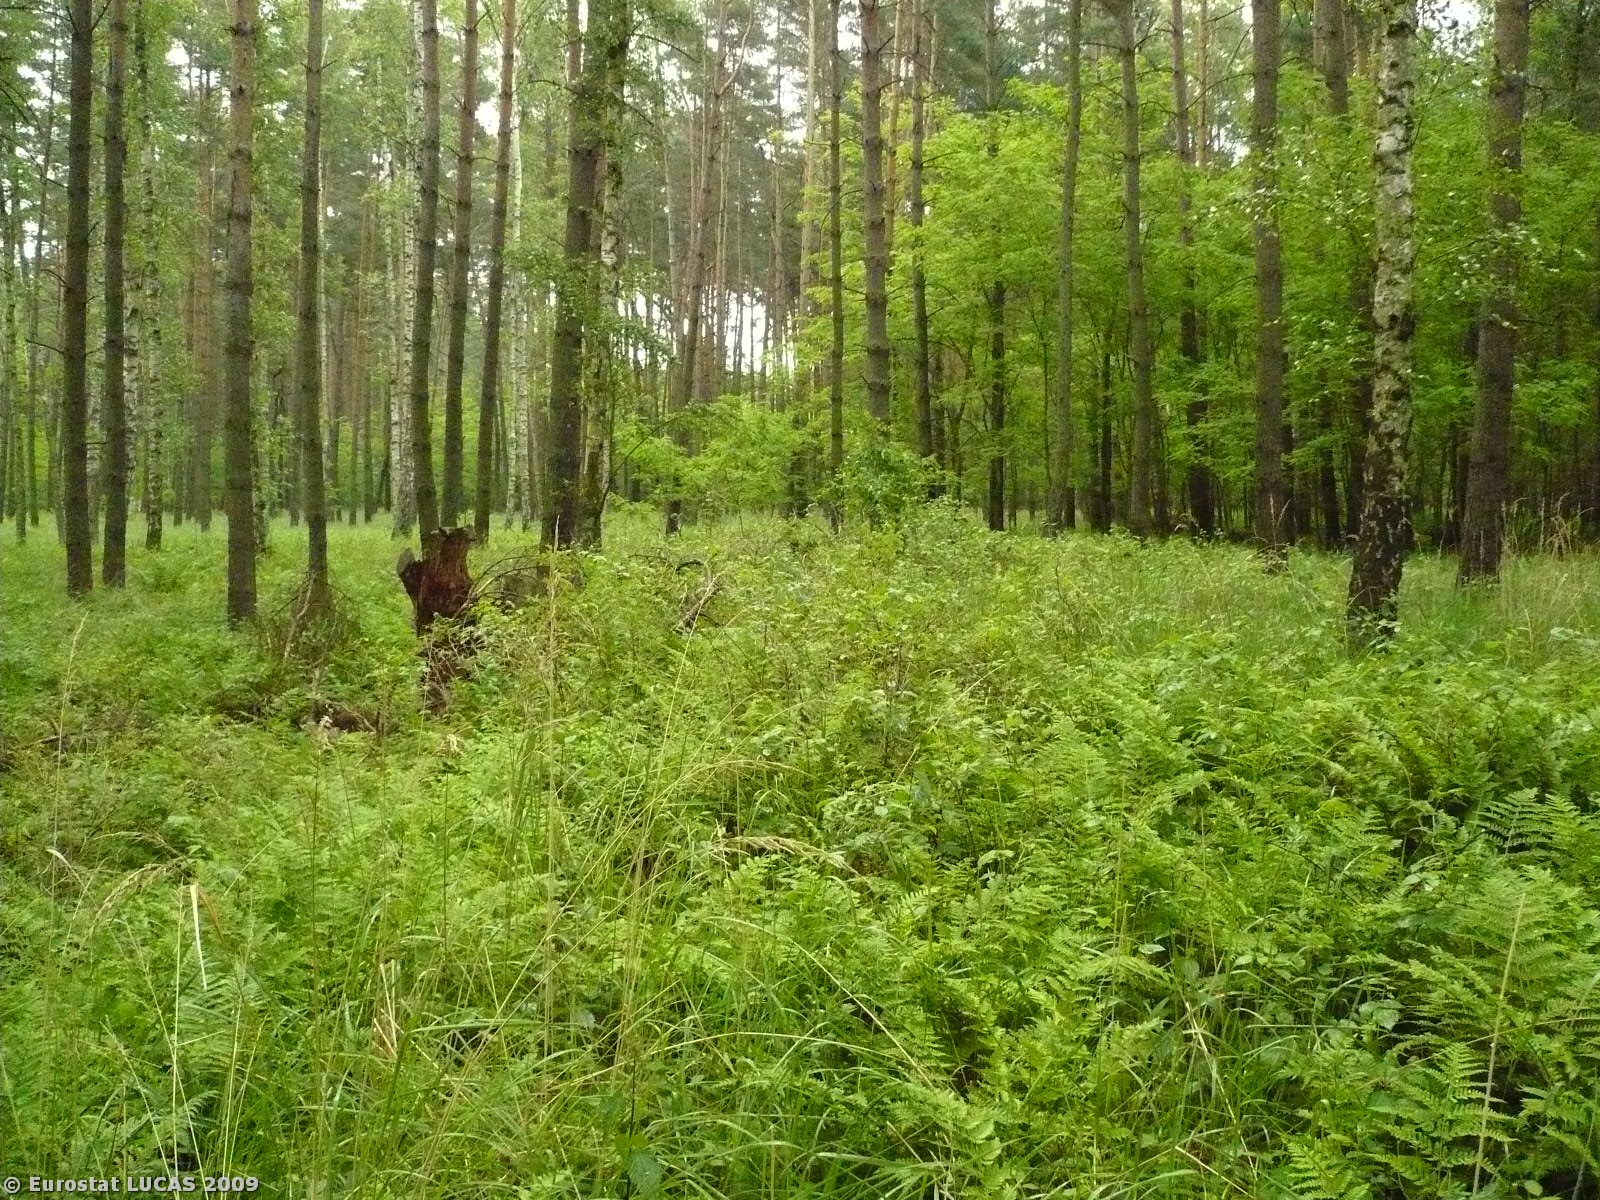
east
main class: Woodland
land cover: Coniferous woodland
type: hemiboreal forest and nemoral coniferous forest and mixed broadleaved-coniferous forest
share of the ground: > 75 %
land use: Forestry
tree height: > 5 m
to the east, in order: Coniferous woodland; Tracks; Coniferous woodland
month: May
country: PL
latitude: 51.9002
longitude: 15.6581
